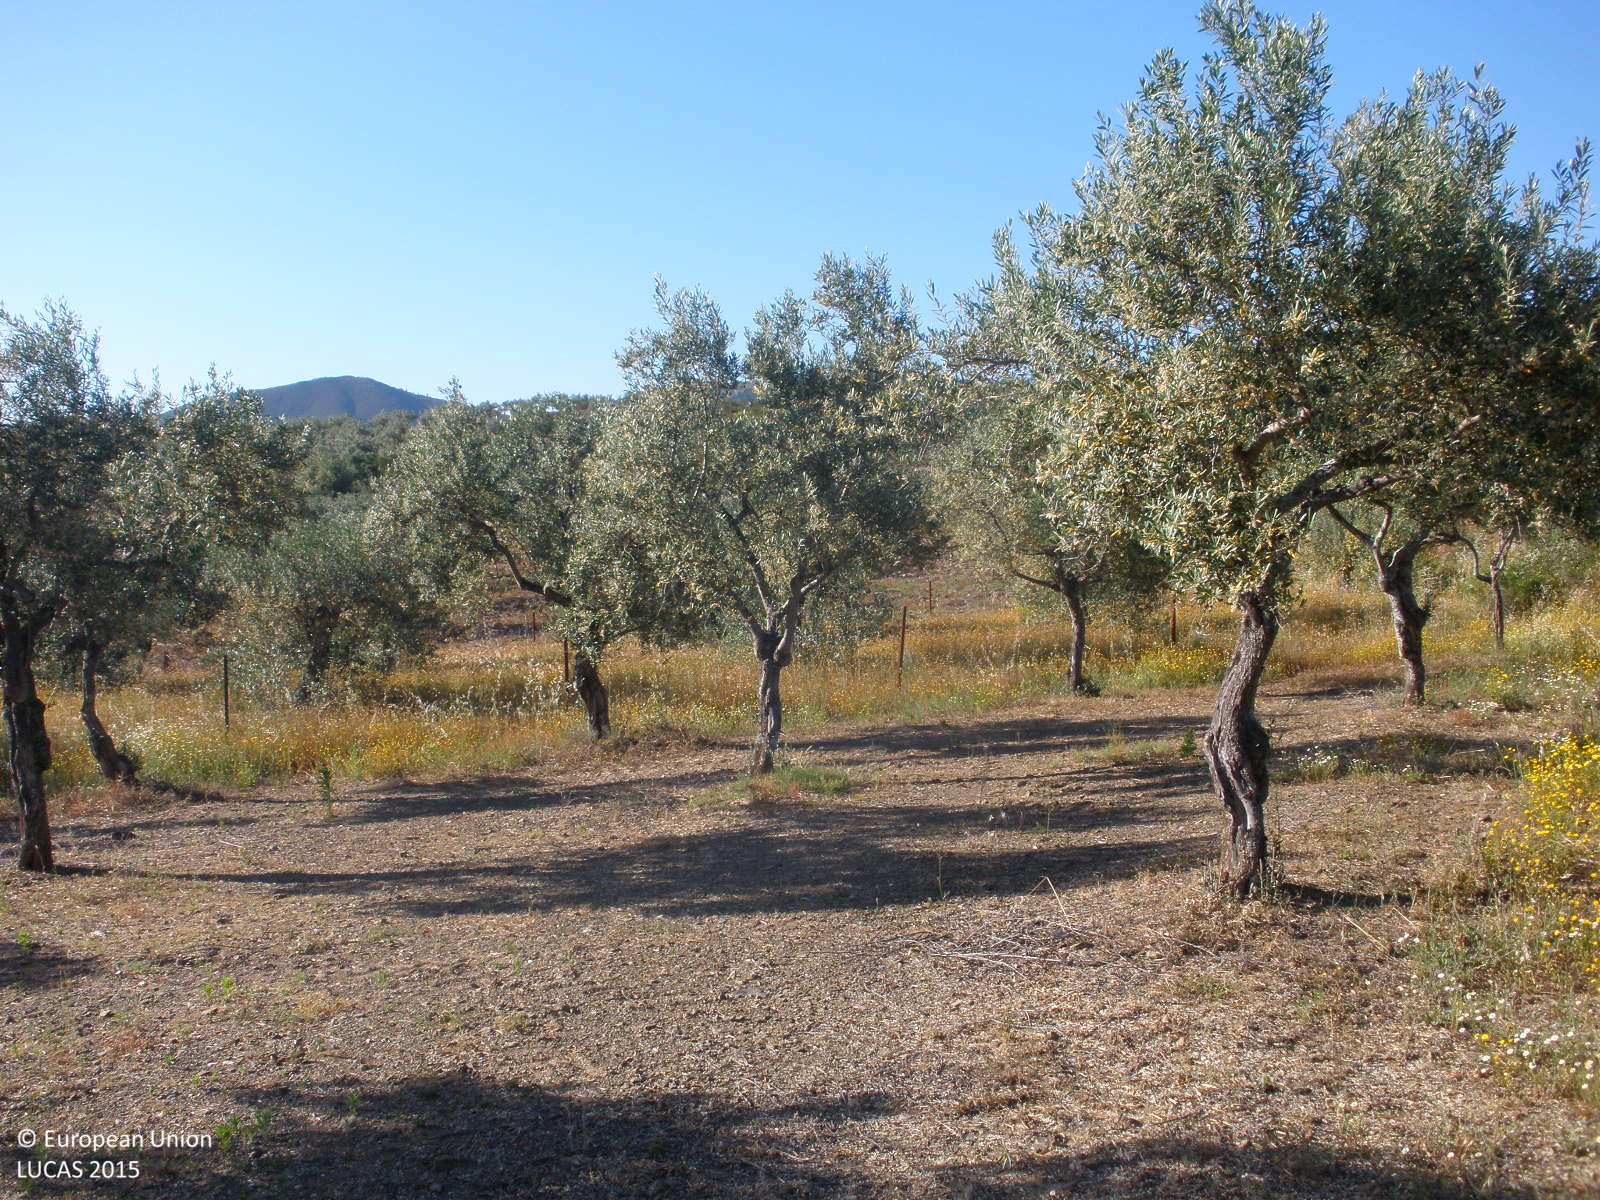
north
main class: Cropland
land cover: Olive groves
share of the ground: 50 - 75 %
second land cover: Spontaneously vegetated surfaces
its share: > 75 %
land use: Agriculture (excluding fallow land and kitchen gardens)
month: May
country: ES
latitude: 40.2552
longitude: -6.1963
